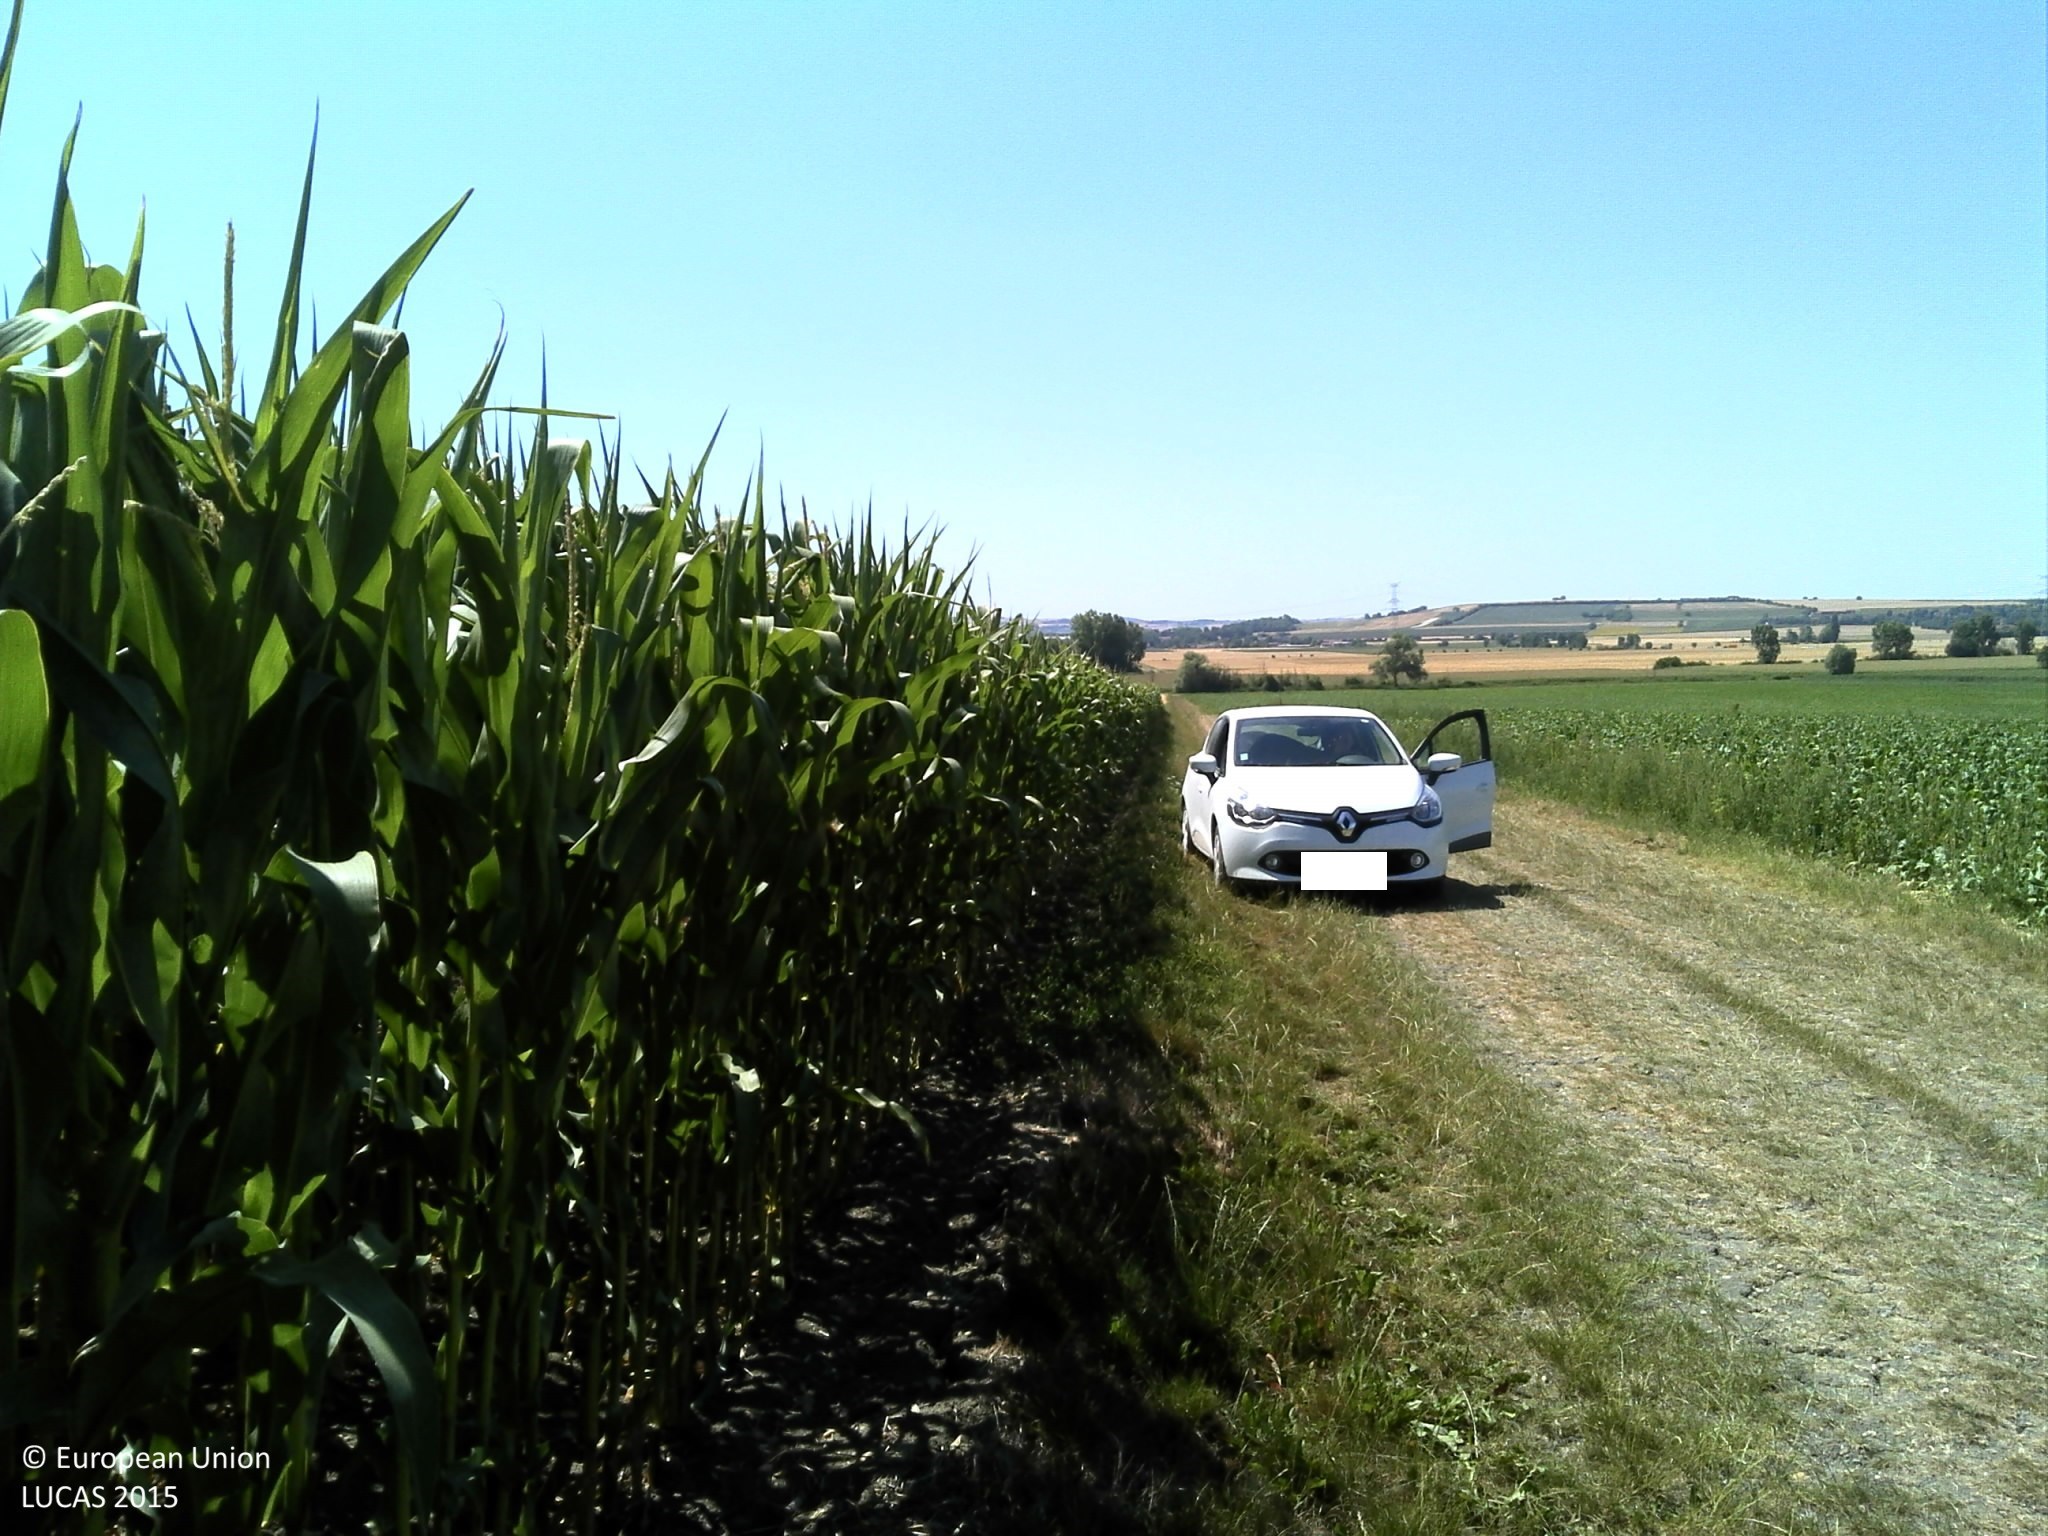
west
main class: Cropland
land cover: Maize
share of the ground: > 75 %
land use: Agriculture (excluding fallow land and kitchen gardens)
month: October
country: FR
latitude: 46.0322
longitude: 3.2941
